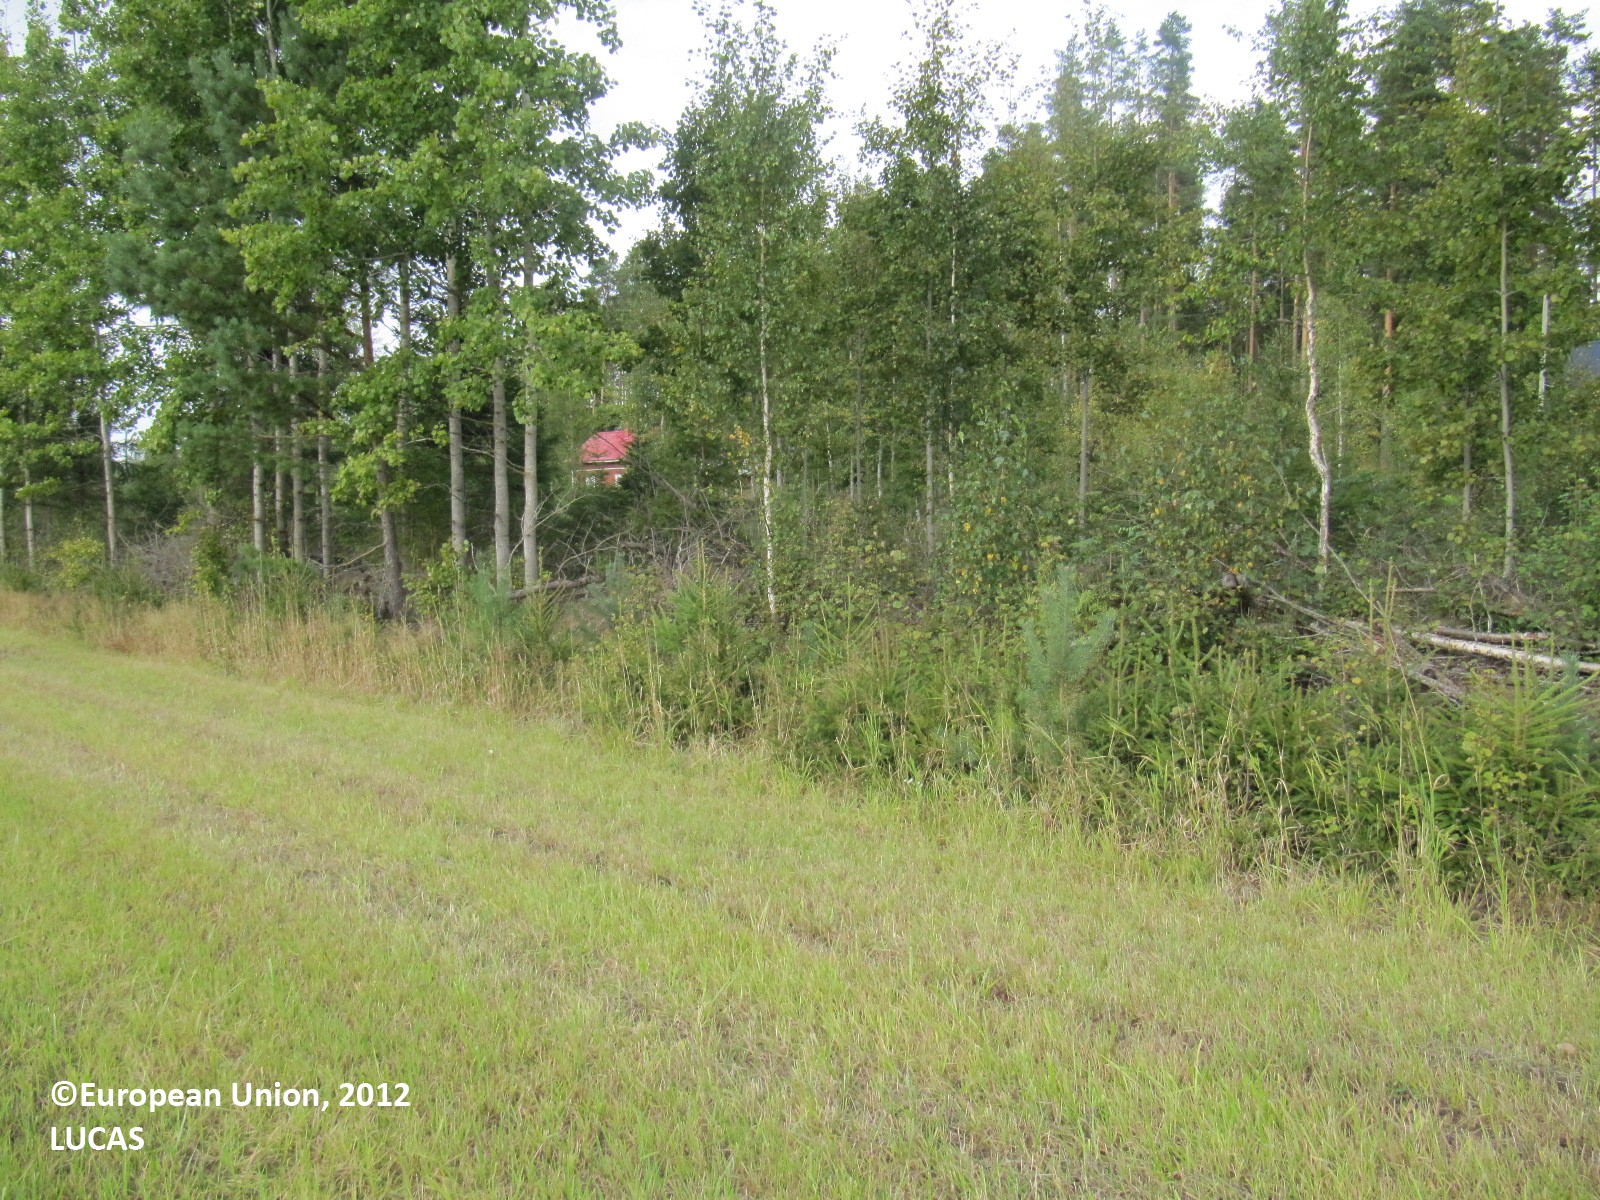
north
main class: Grassland
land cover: Spontaneously vegetated surfaces
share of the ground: > 75 %
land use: Agriculture (excluding fallow land and kitchen gardens)
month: August
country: FI
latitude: 61.0826
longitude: 22.9203
